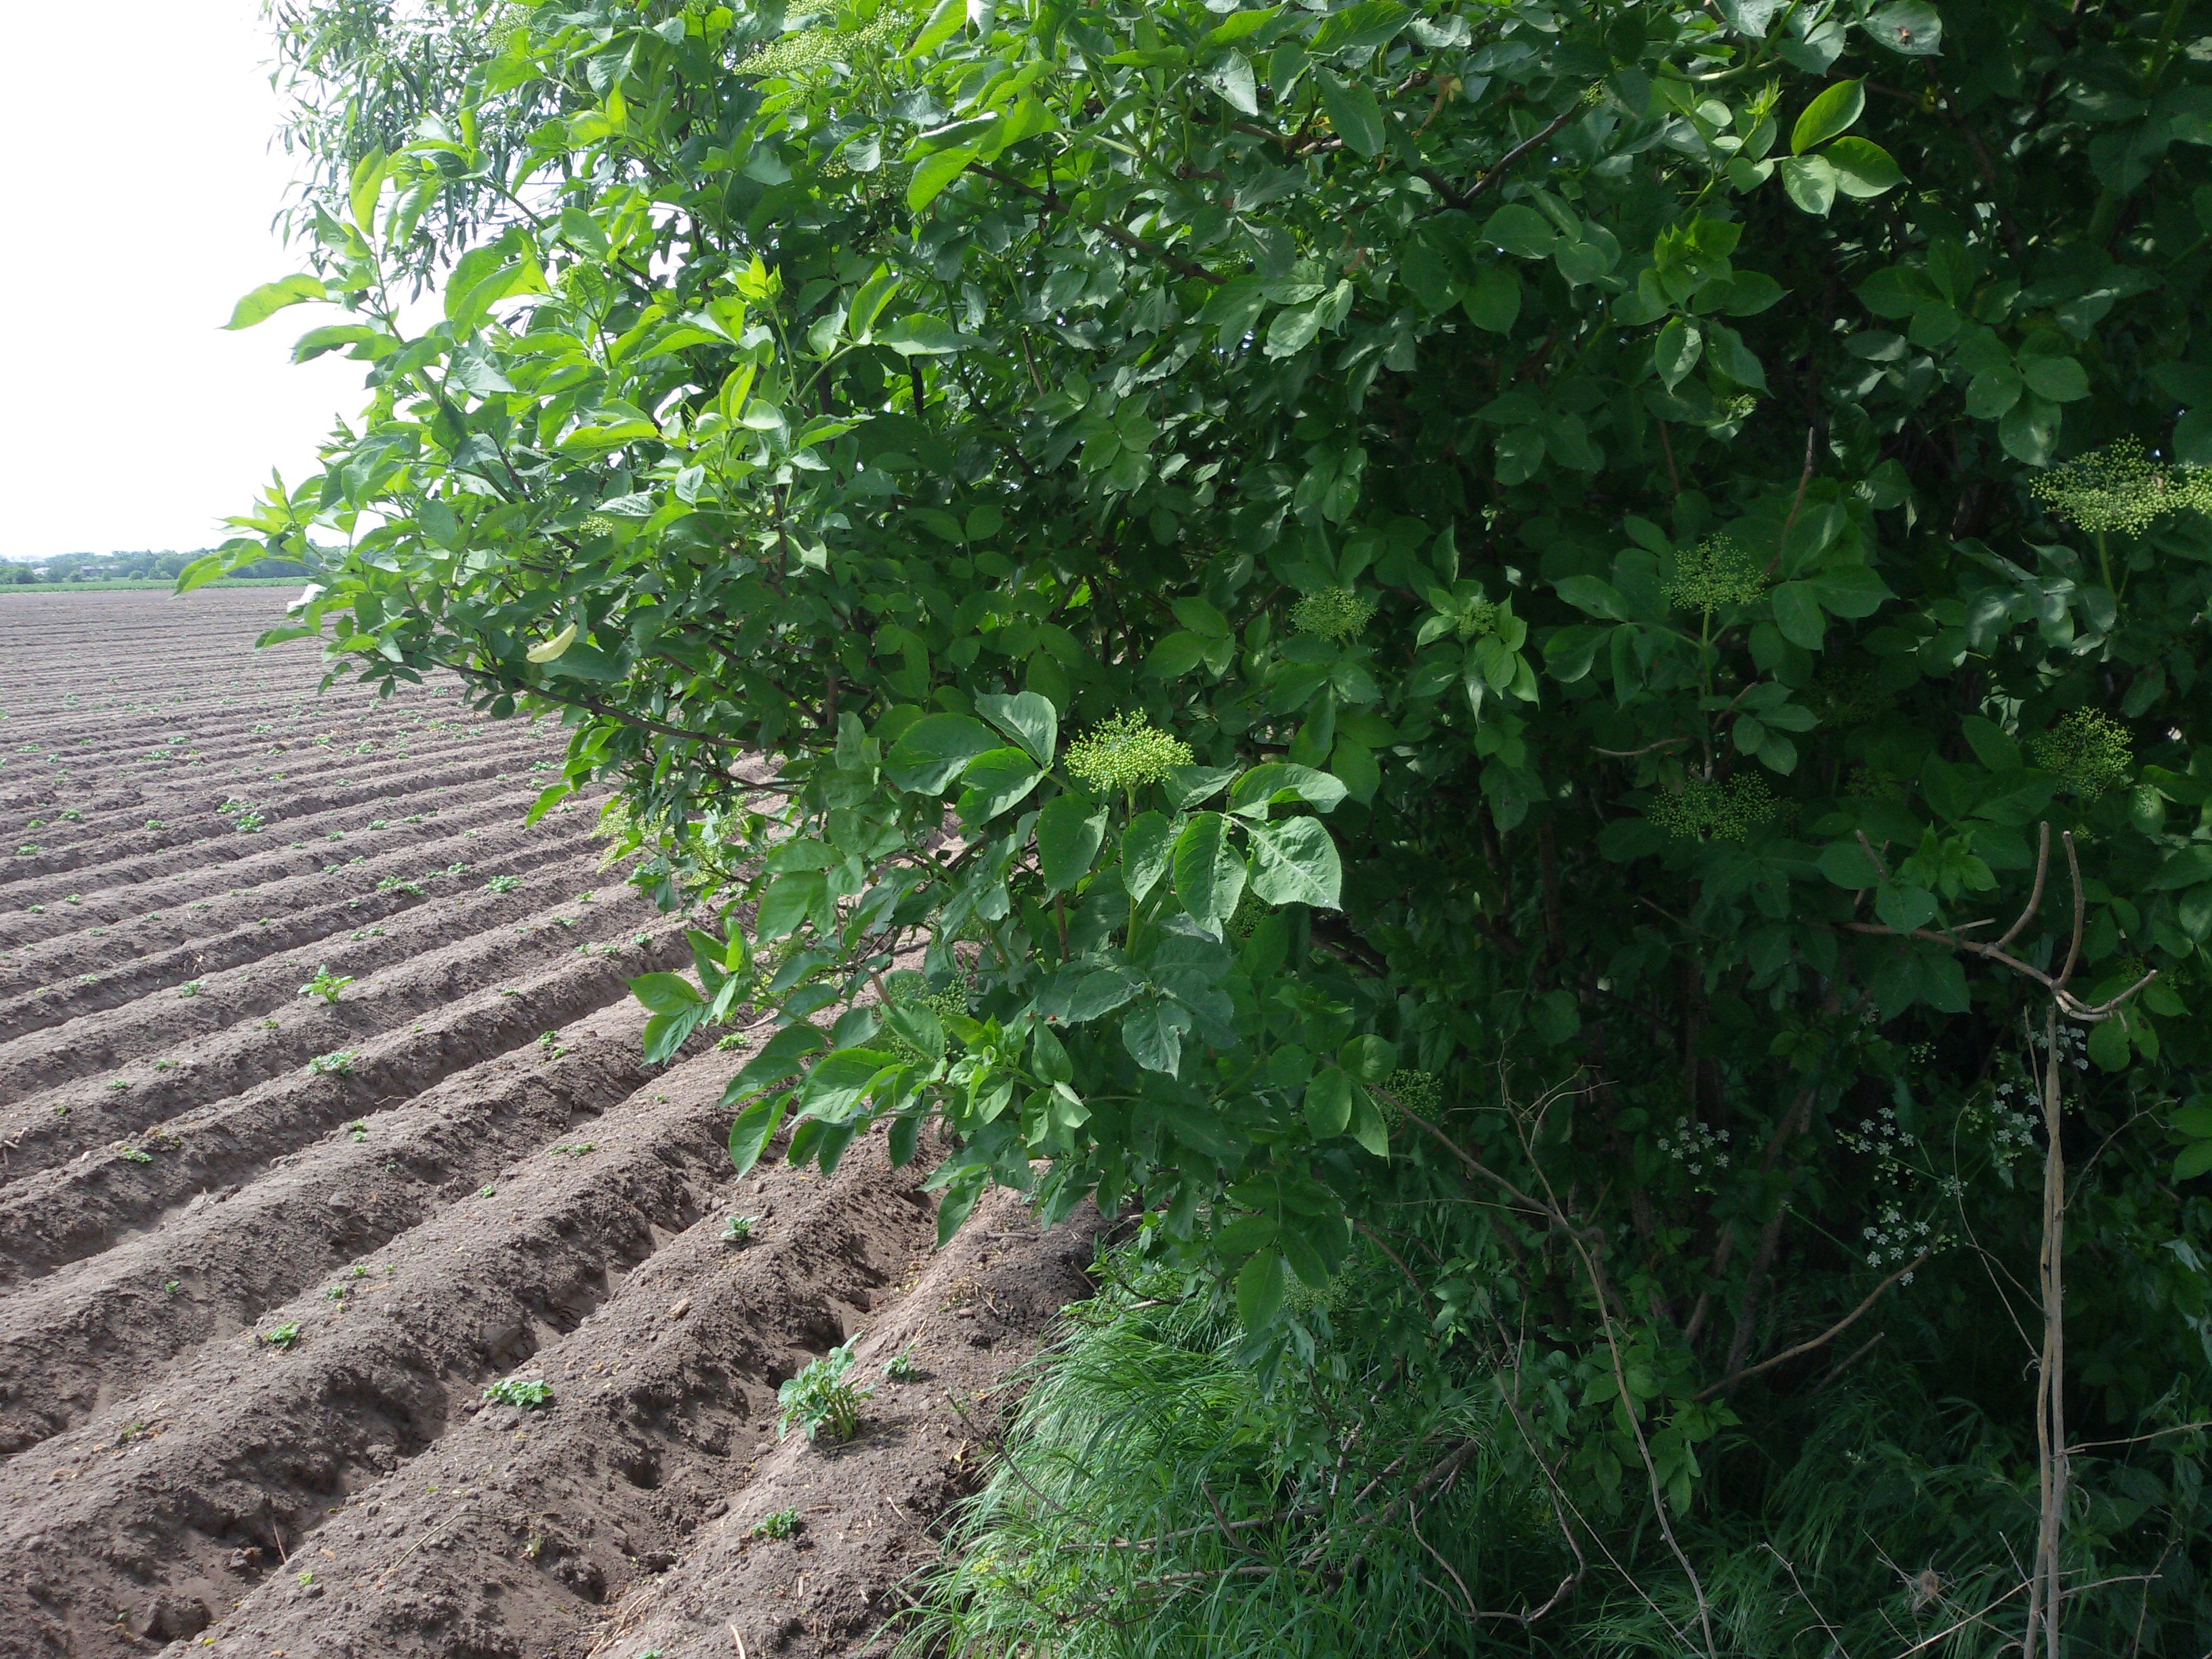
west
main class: Cropland
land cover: Potatoes
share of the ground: > 75 %
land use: Agriculture (excluding fallow land and kitchen gardens)
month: May
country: PL
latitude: 52.2166
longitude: 17.1387
